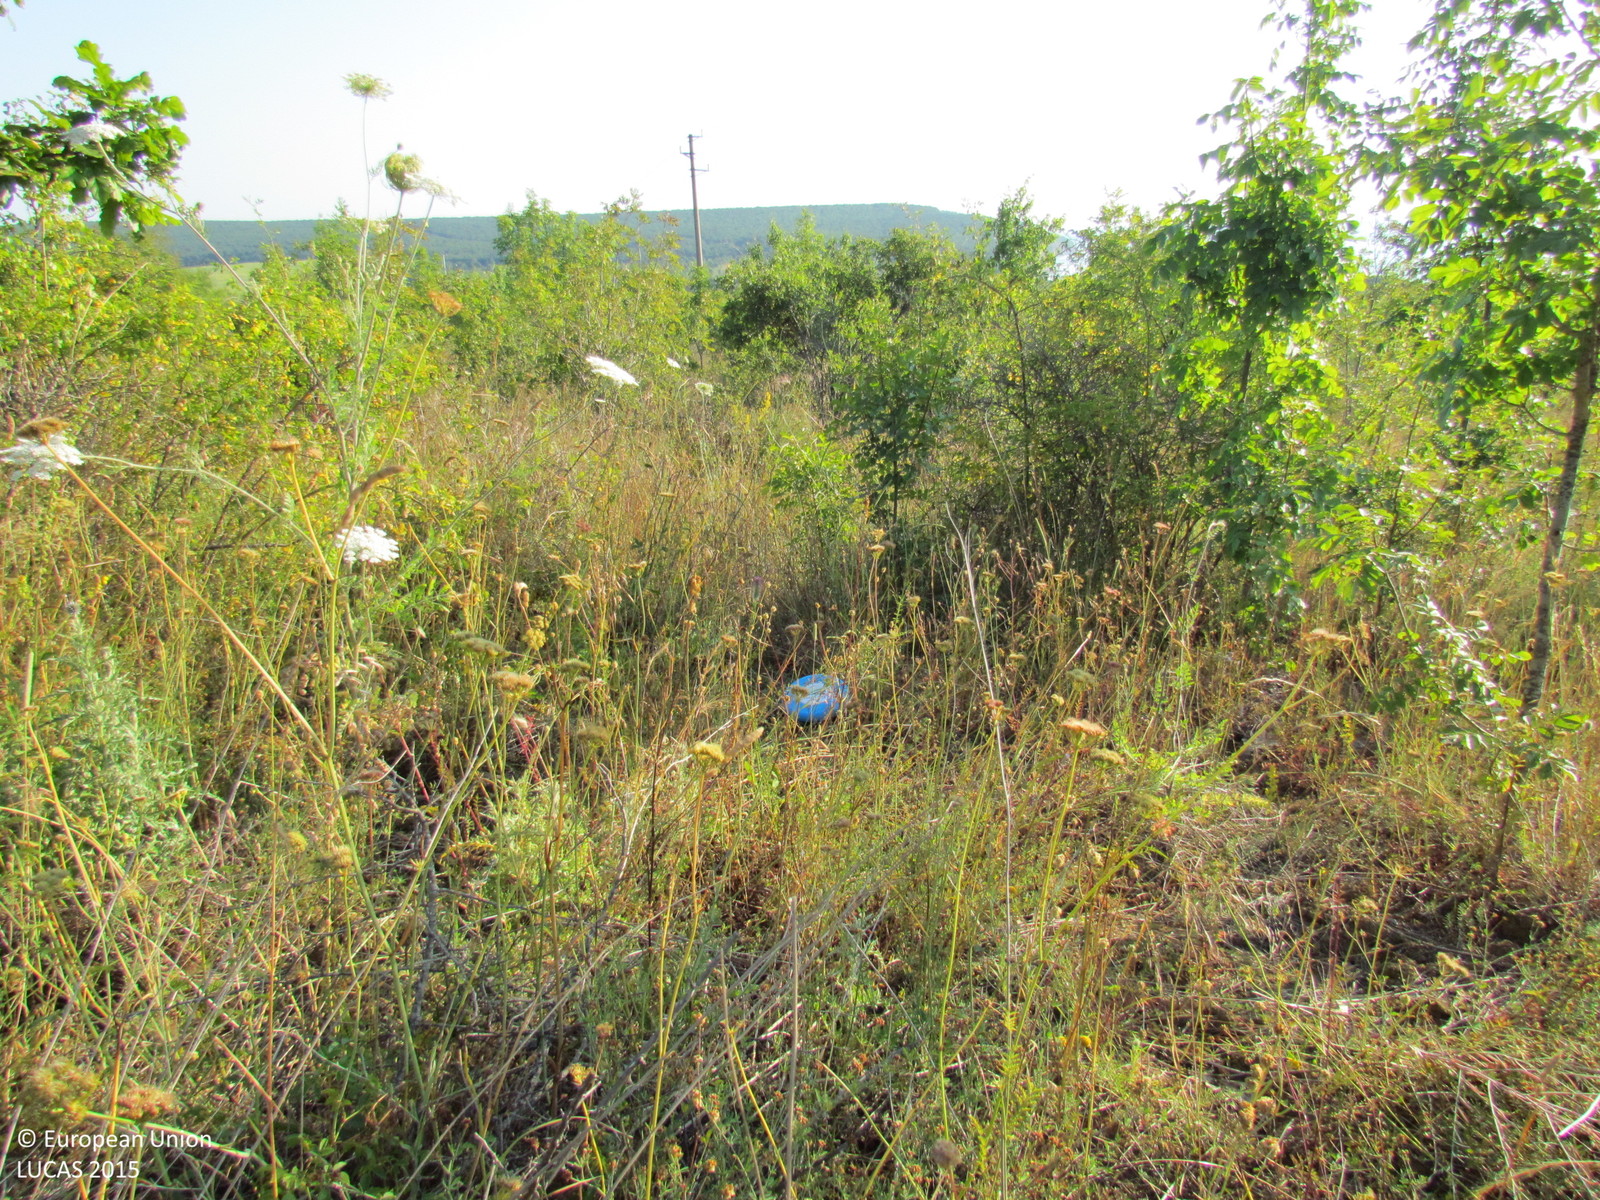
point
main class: Shrubland
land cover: Shrubland with sparse tree cover
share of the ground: 50 - 75 %
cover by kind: shrubs 55 %, herbaceous plants 40 %, broadleaved forest trees 5 %
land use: Semi-natural and natural areas not in use
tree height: < 5 m
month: July
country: BG
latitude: 42.7447
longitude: 27.8822
